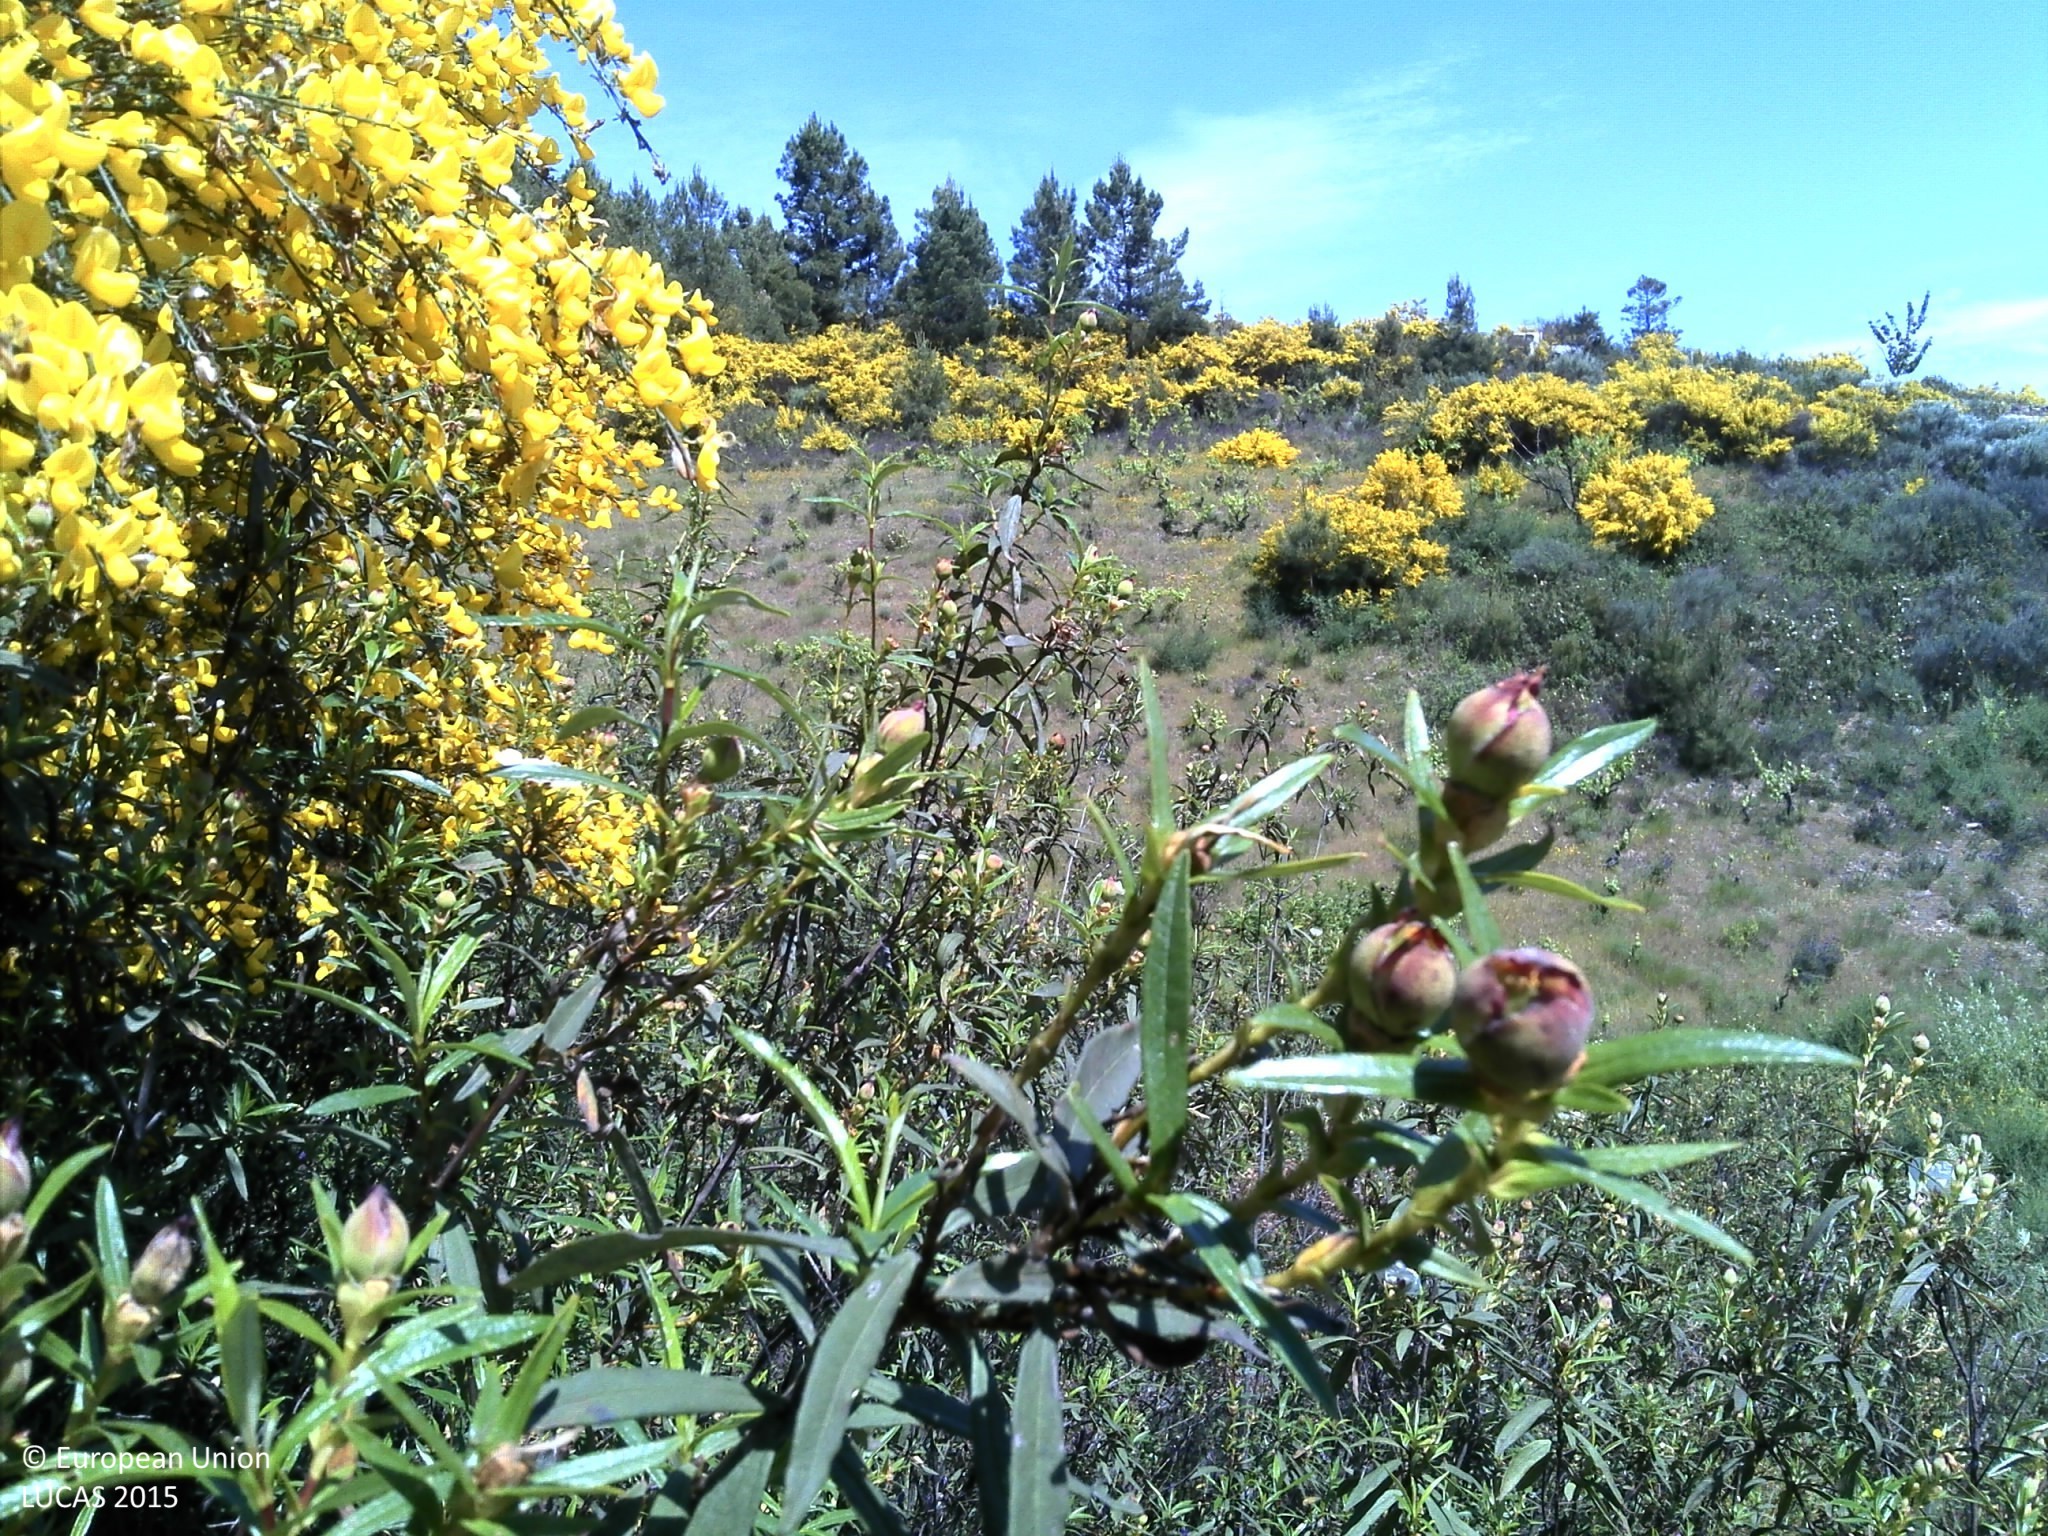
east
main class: Shrubland
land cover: Shrubland with sparse tree cover
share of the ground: > 75 %
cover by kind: shrubs 90 %, coniferous forest trees 5 %, unconsolidated bare surface 5 %
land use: Forestry
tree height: > 5 m
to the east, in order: Shrubland with sparse tree cover; Tracks; Vineyards; Shruby margins; Tracks; Shrubland with sparse tree cover; Tracks; Shrubland with sparse tree cover; Pine dominated coniferous woodland
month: May
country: PT
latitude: 41.7380
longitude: -7.1102
